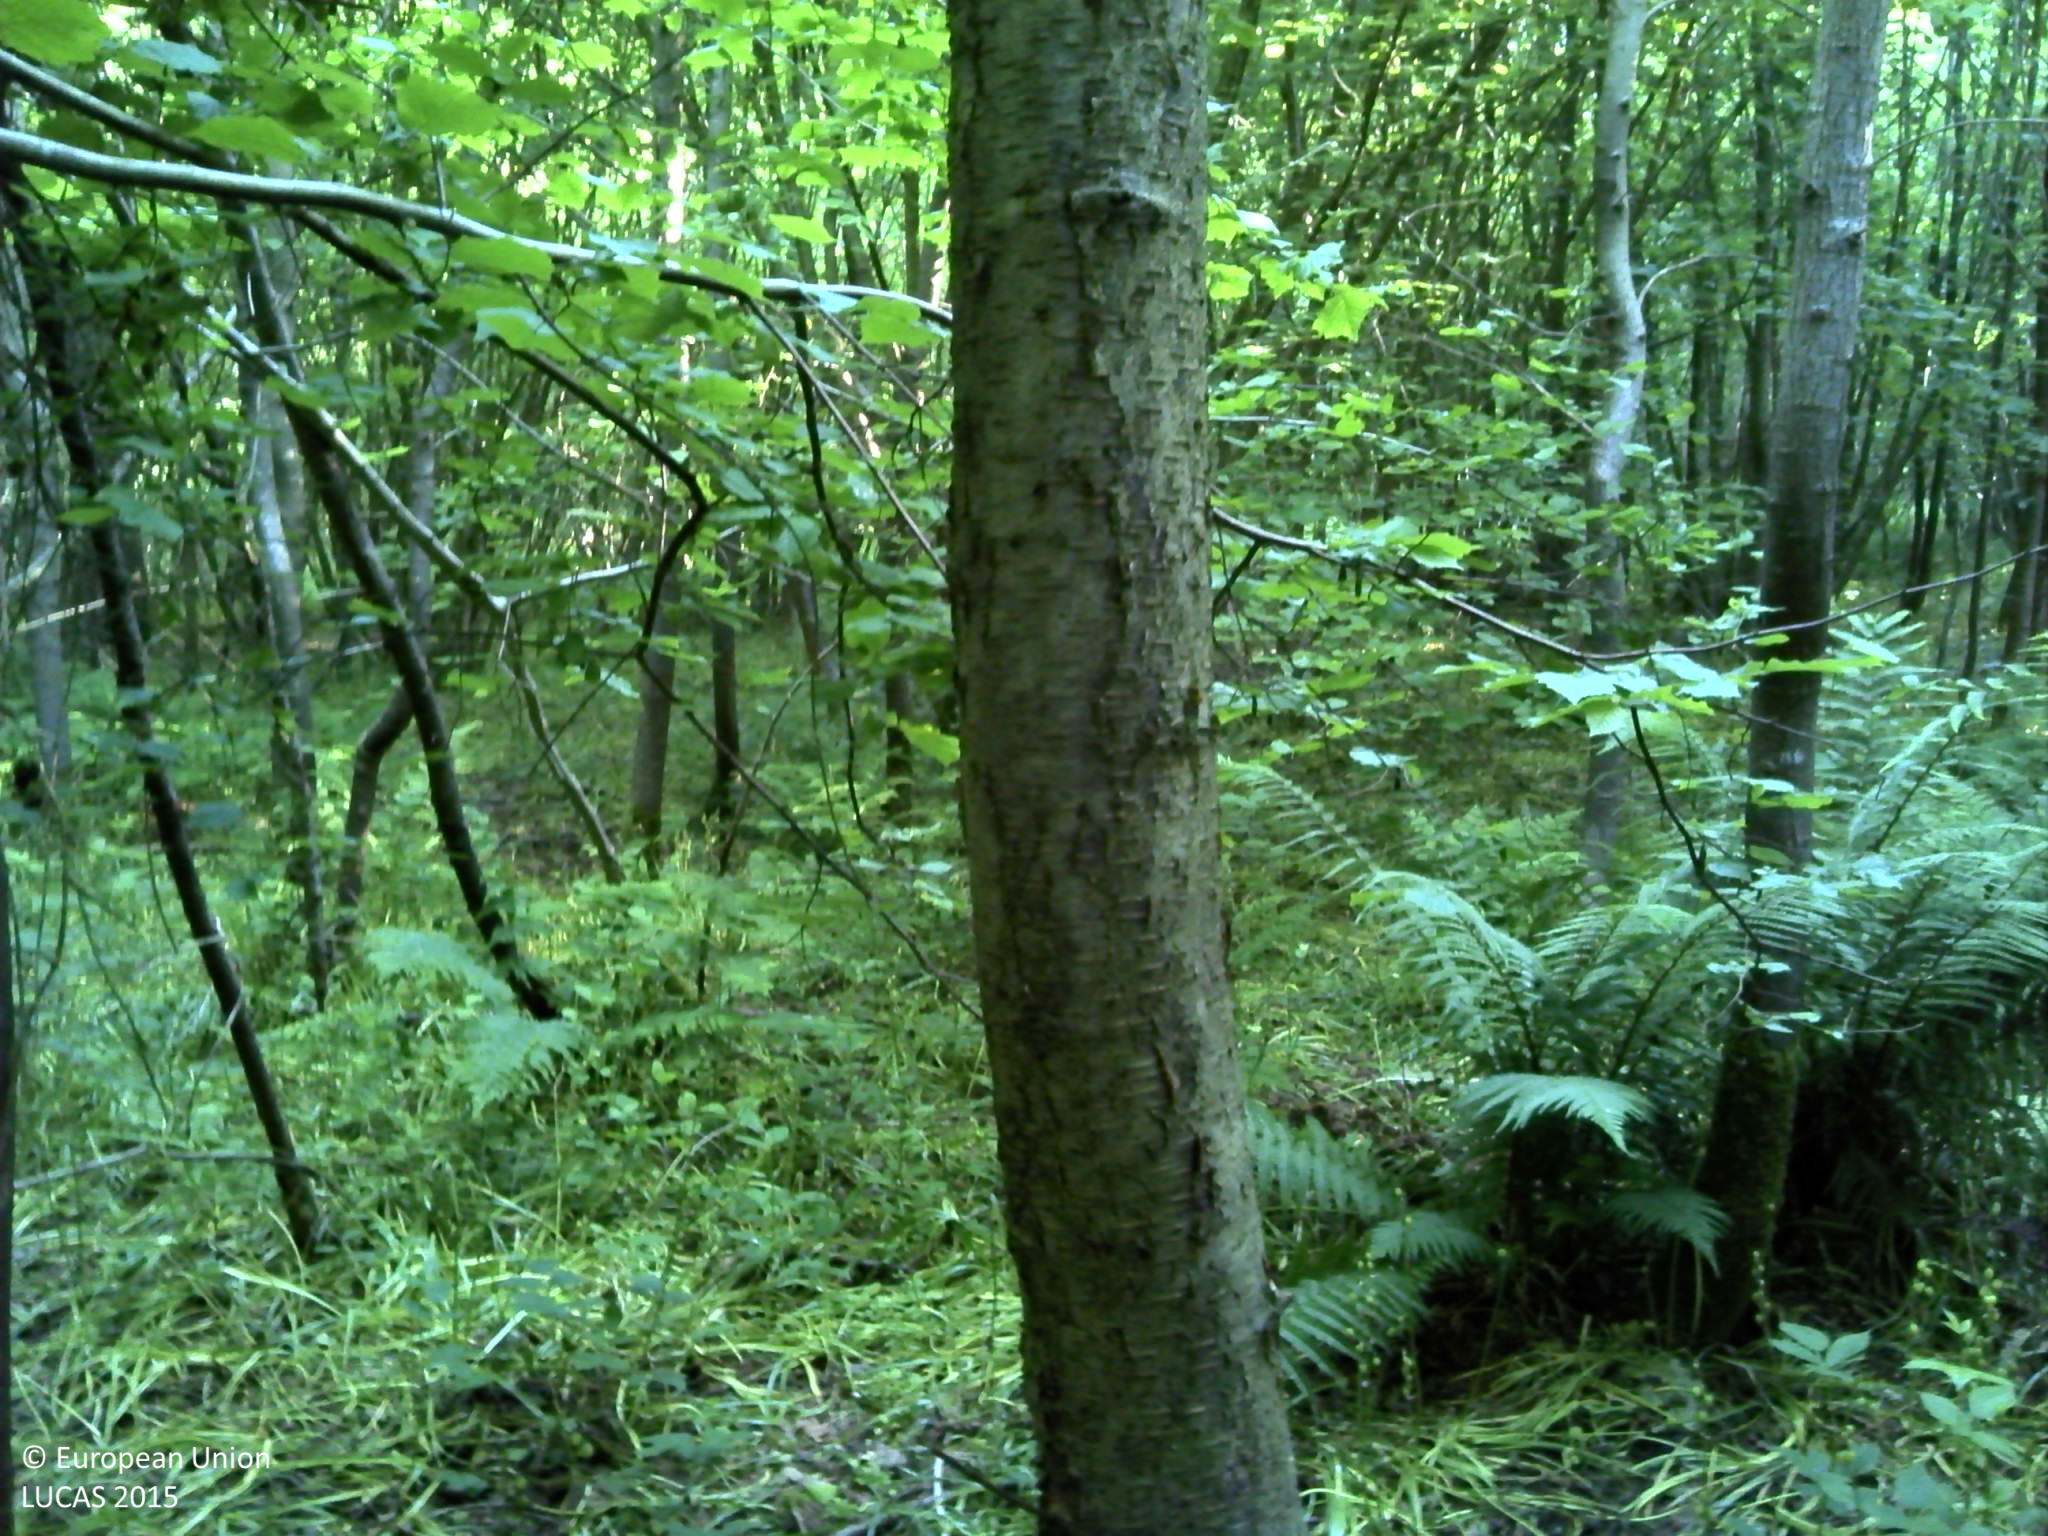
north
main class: Woodland
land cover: Broadleaved woodland
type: mesophytic deciduous forest
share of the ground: > 75 %
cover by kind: broadleaved forest trees 80 %, herbaceous plants 20 %
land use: Forestry
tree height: > 5 m
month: June
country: FR
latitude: 49.6946
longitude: 1.1478
